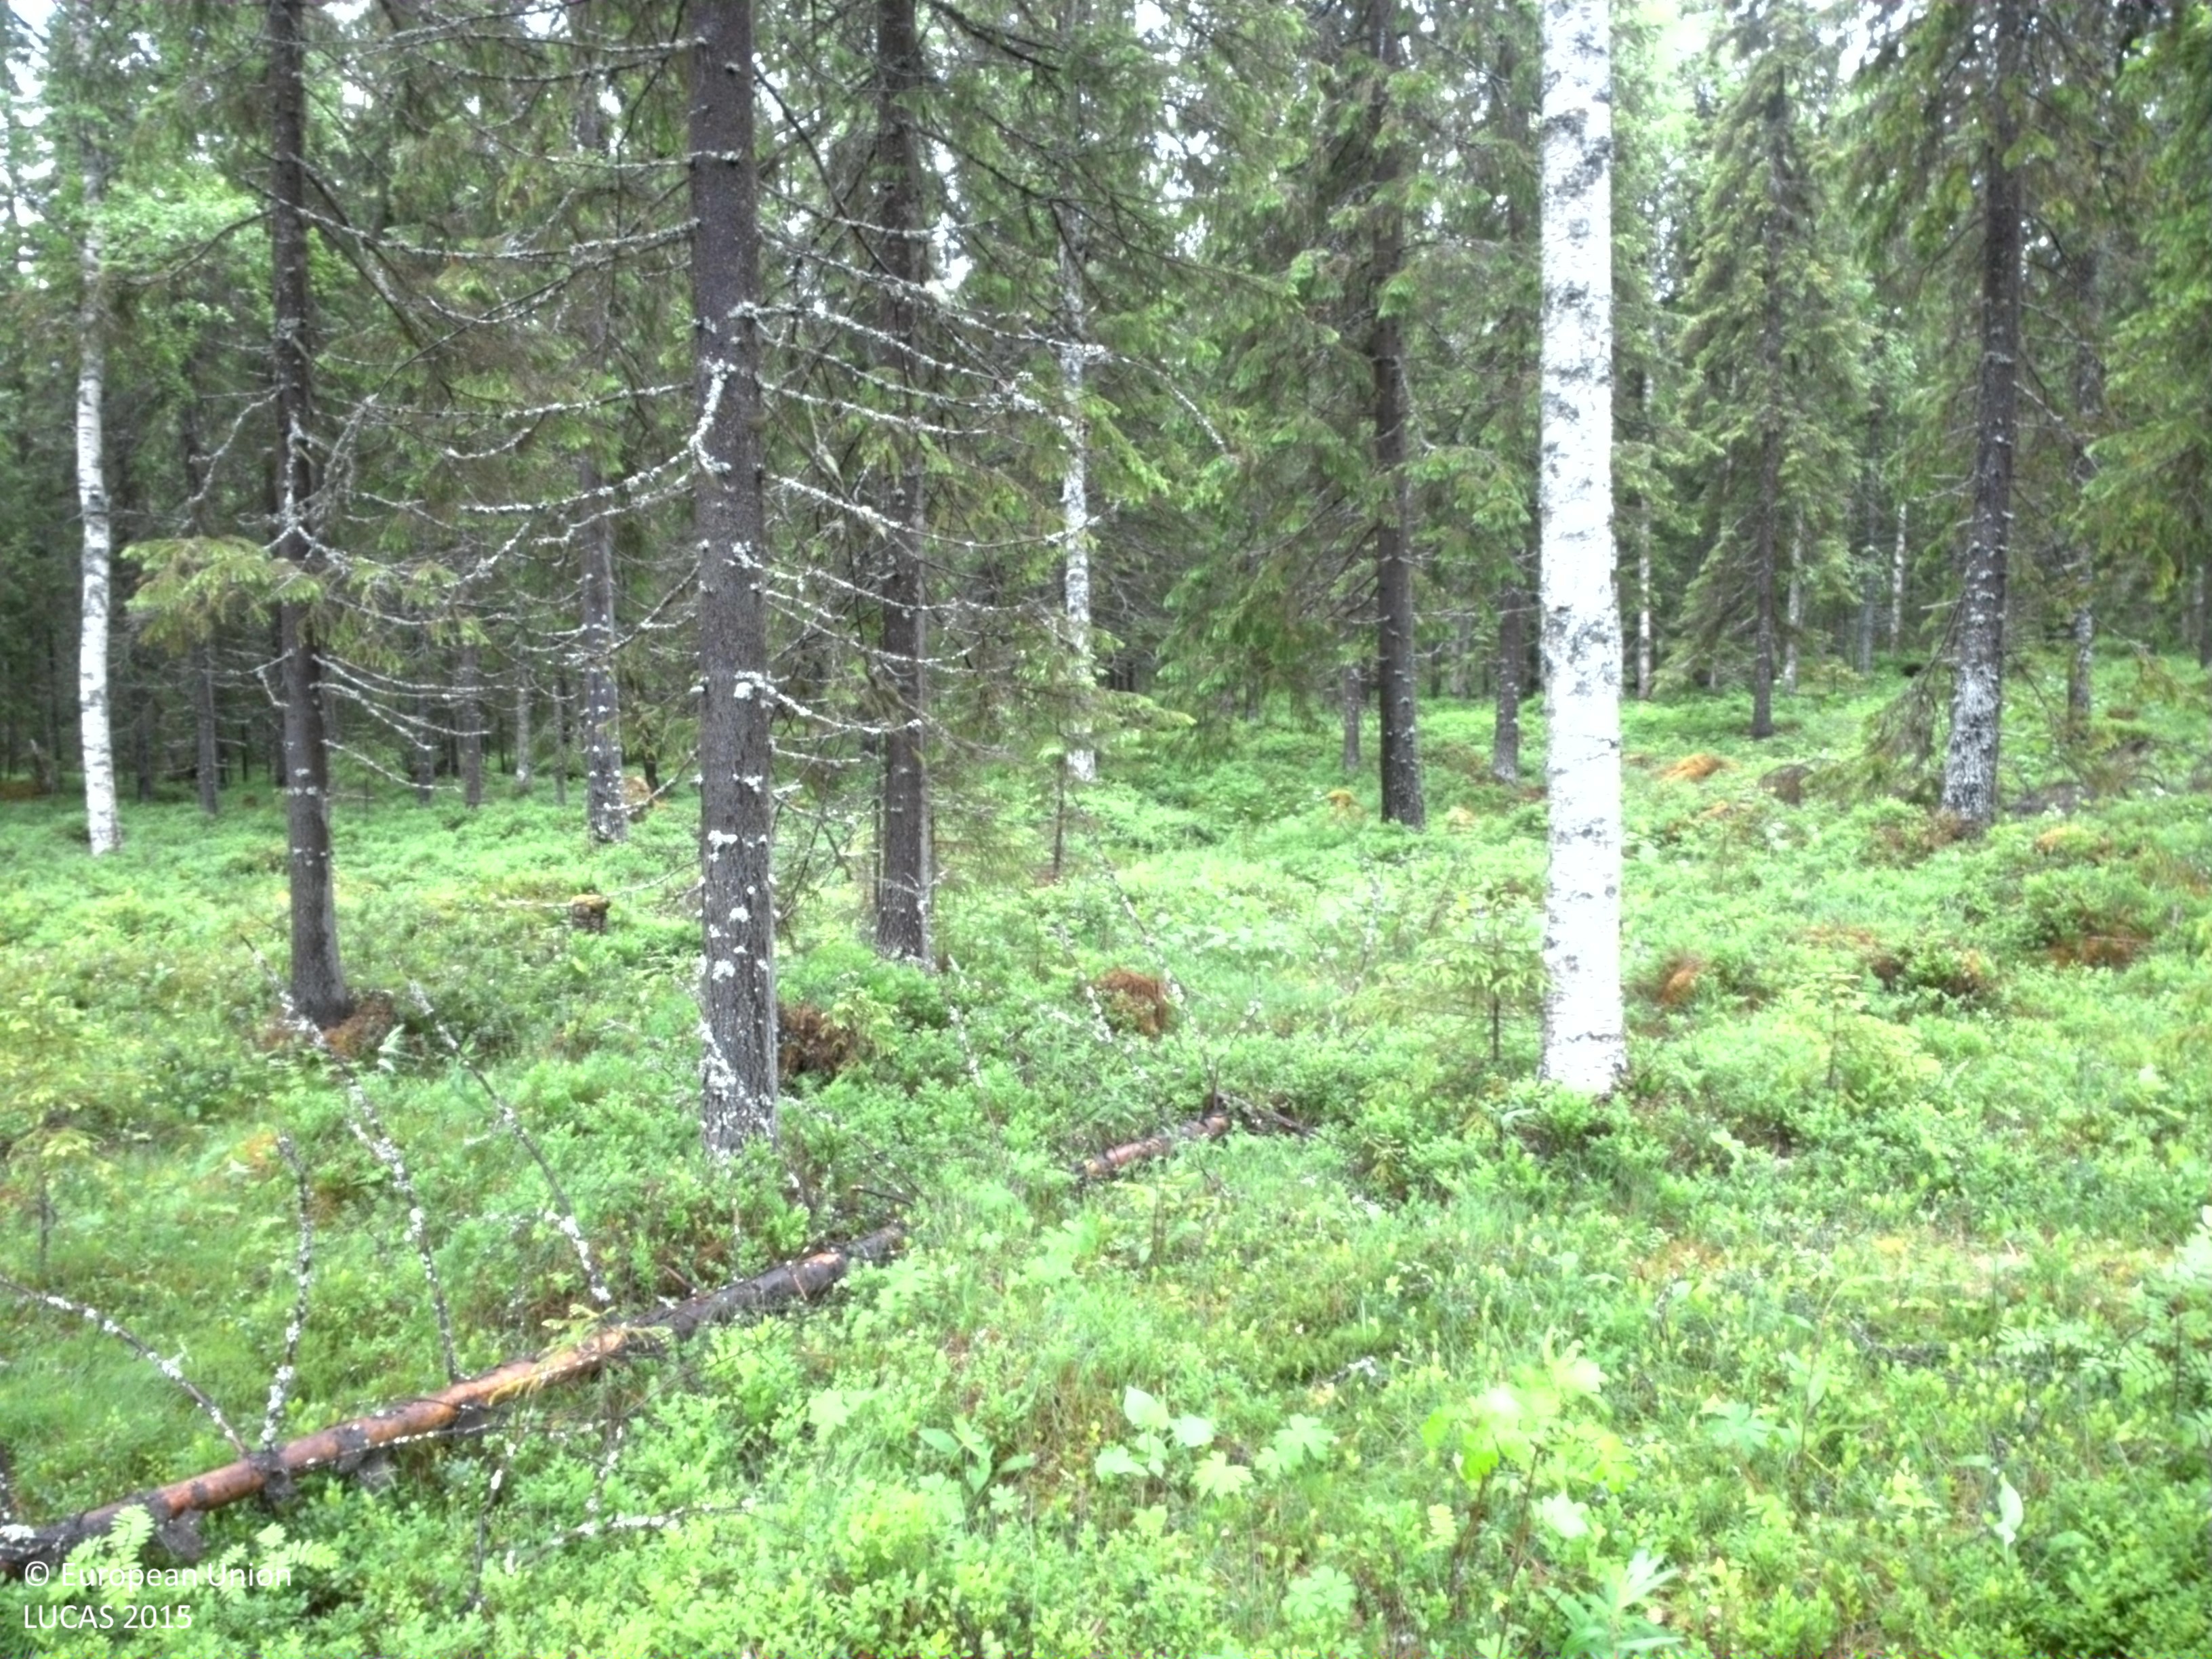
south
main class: Woodland
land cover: Spruce dominated mixed woodland
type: boreal forest
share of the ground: 50 - 75 %
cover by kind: coniferous forest trees 45 %, shrubs 35 %, broadleaved forest trees 15 %, herbaceous plants 5 %
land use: Forestry
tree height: > 5 m
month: July
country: SE
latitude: 64.5733
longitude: 18.0872
